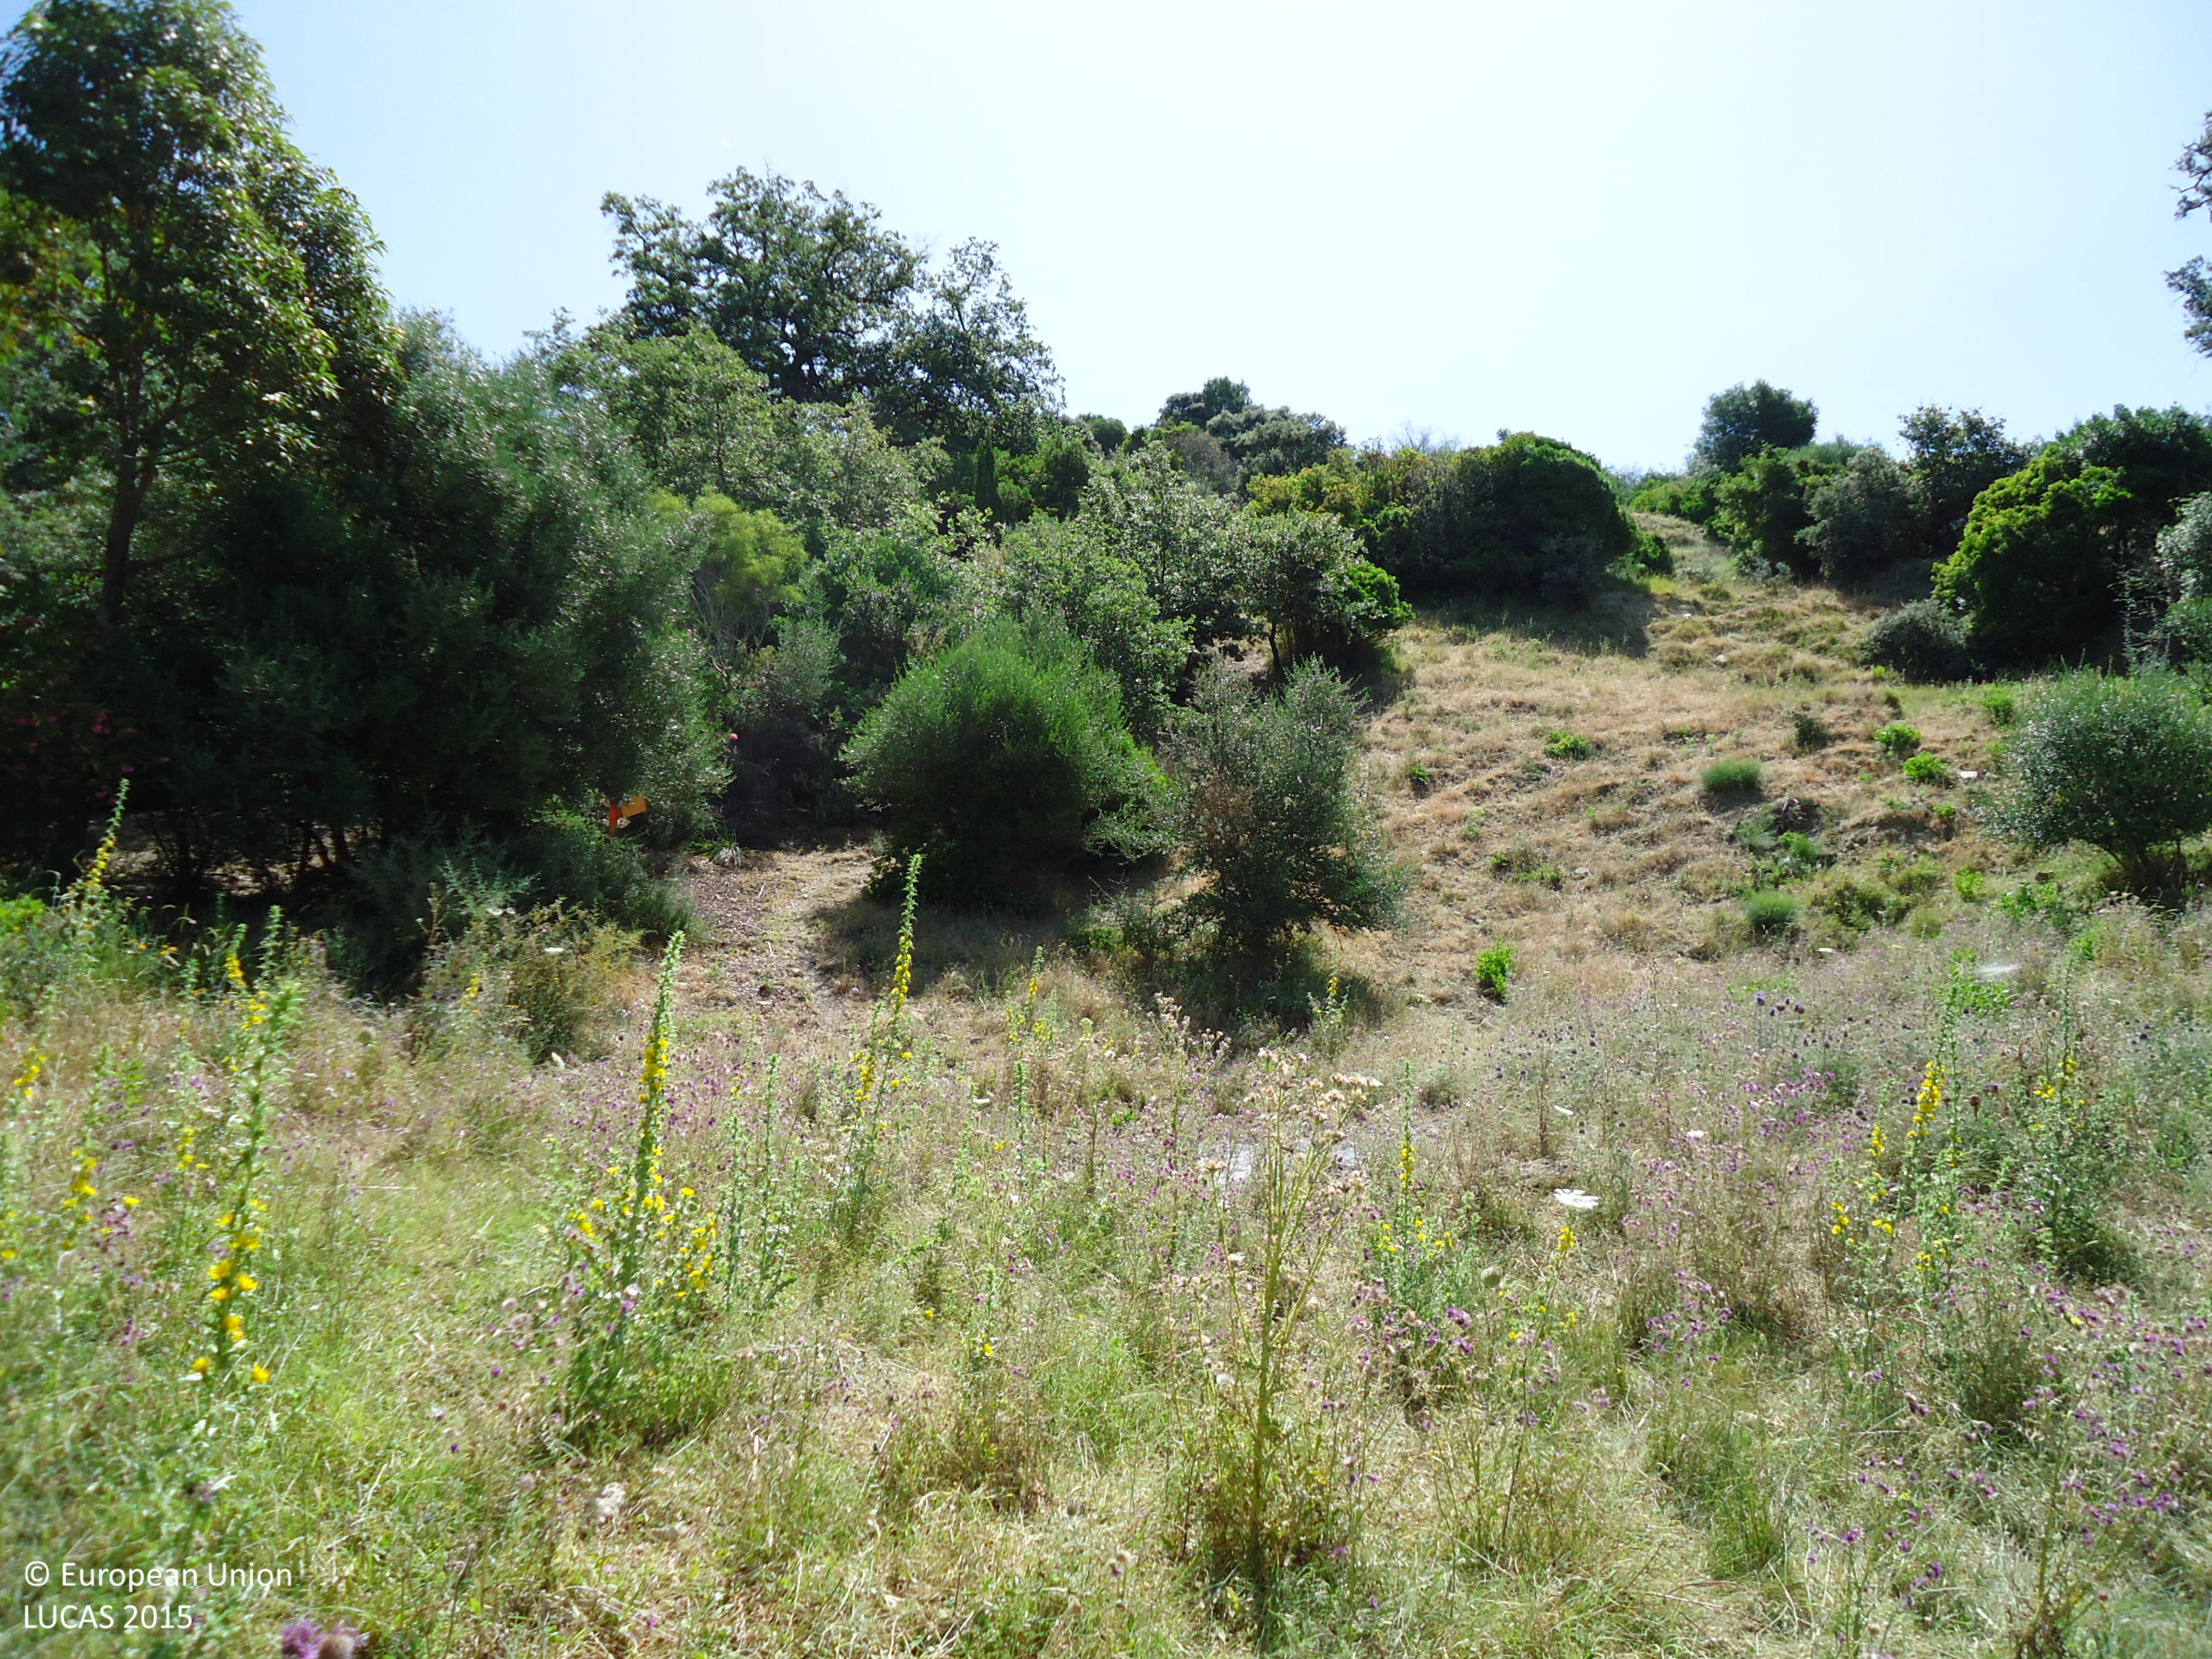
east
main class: Grassland
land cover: Grassland with sparse tree/shrub cover
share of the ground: > 75 %
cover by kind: herbaceous plants 95 %, broadleaved forest trees 5 %
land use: Agriculture (excluding fallow land and kitchen gardens)
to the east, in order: Grassland with sparse tree/shrub cover; Broadleaved woodland; Fences; Grassland without tree/shrub cover; Broadleaved woodland; Tracks; Grassland without tree/shrub cover
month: June
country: ES
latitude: 36.4902
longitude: -5.3685
